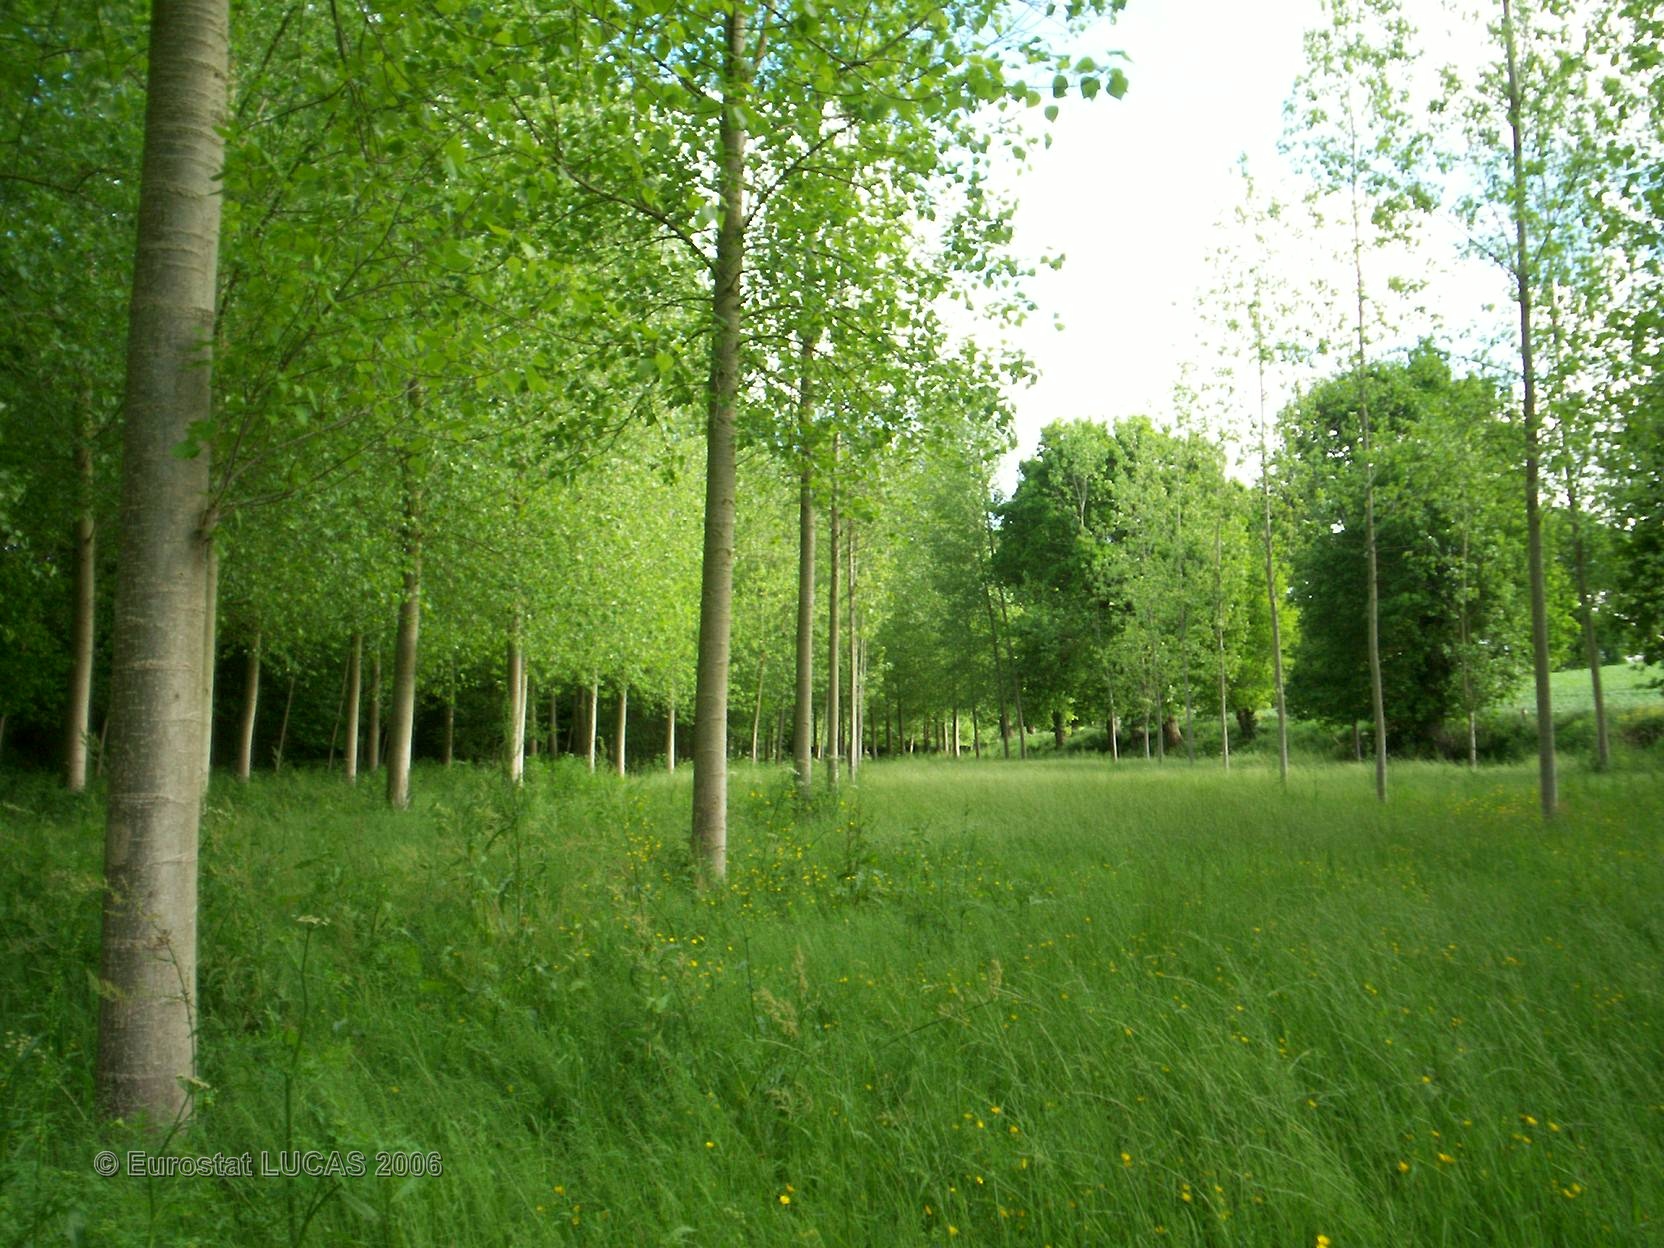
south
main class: Woodland
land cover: Broadleaved forest
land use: Forestry
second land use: Wetland
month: May
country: FR
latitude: 48.4214
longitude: -2.4794
